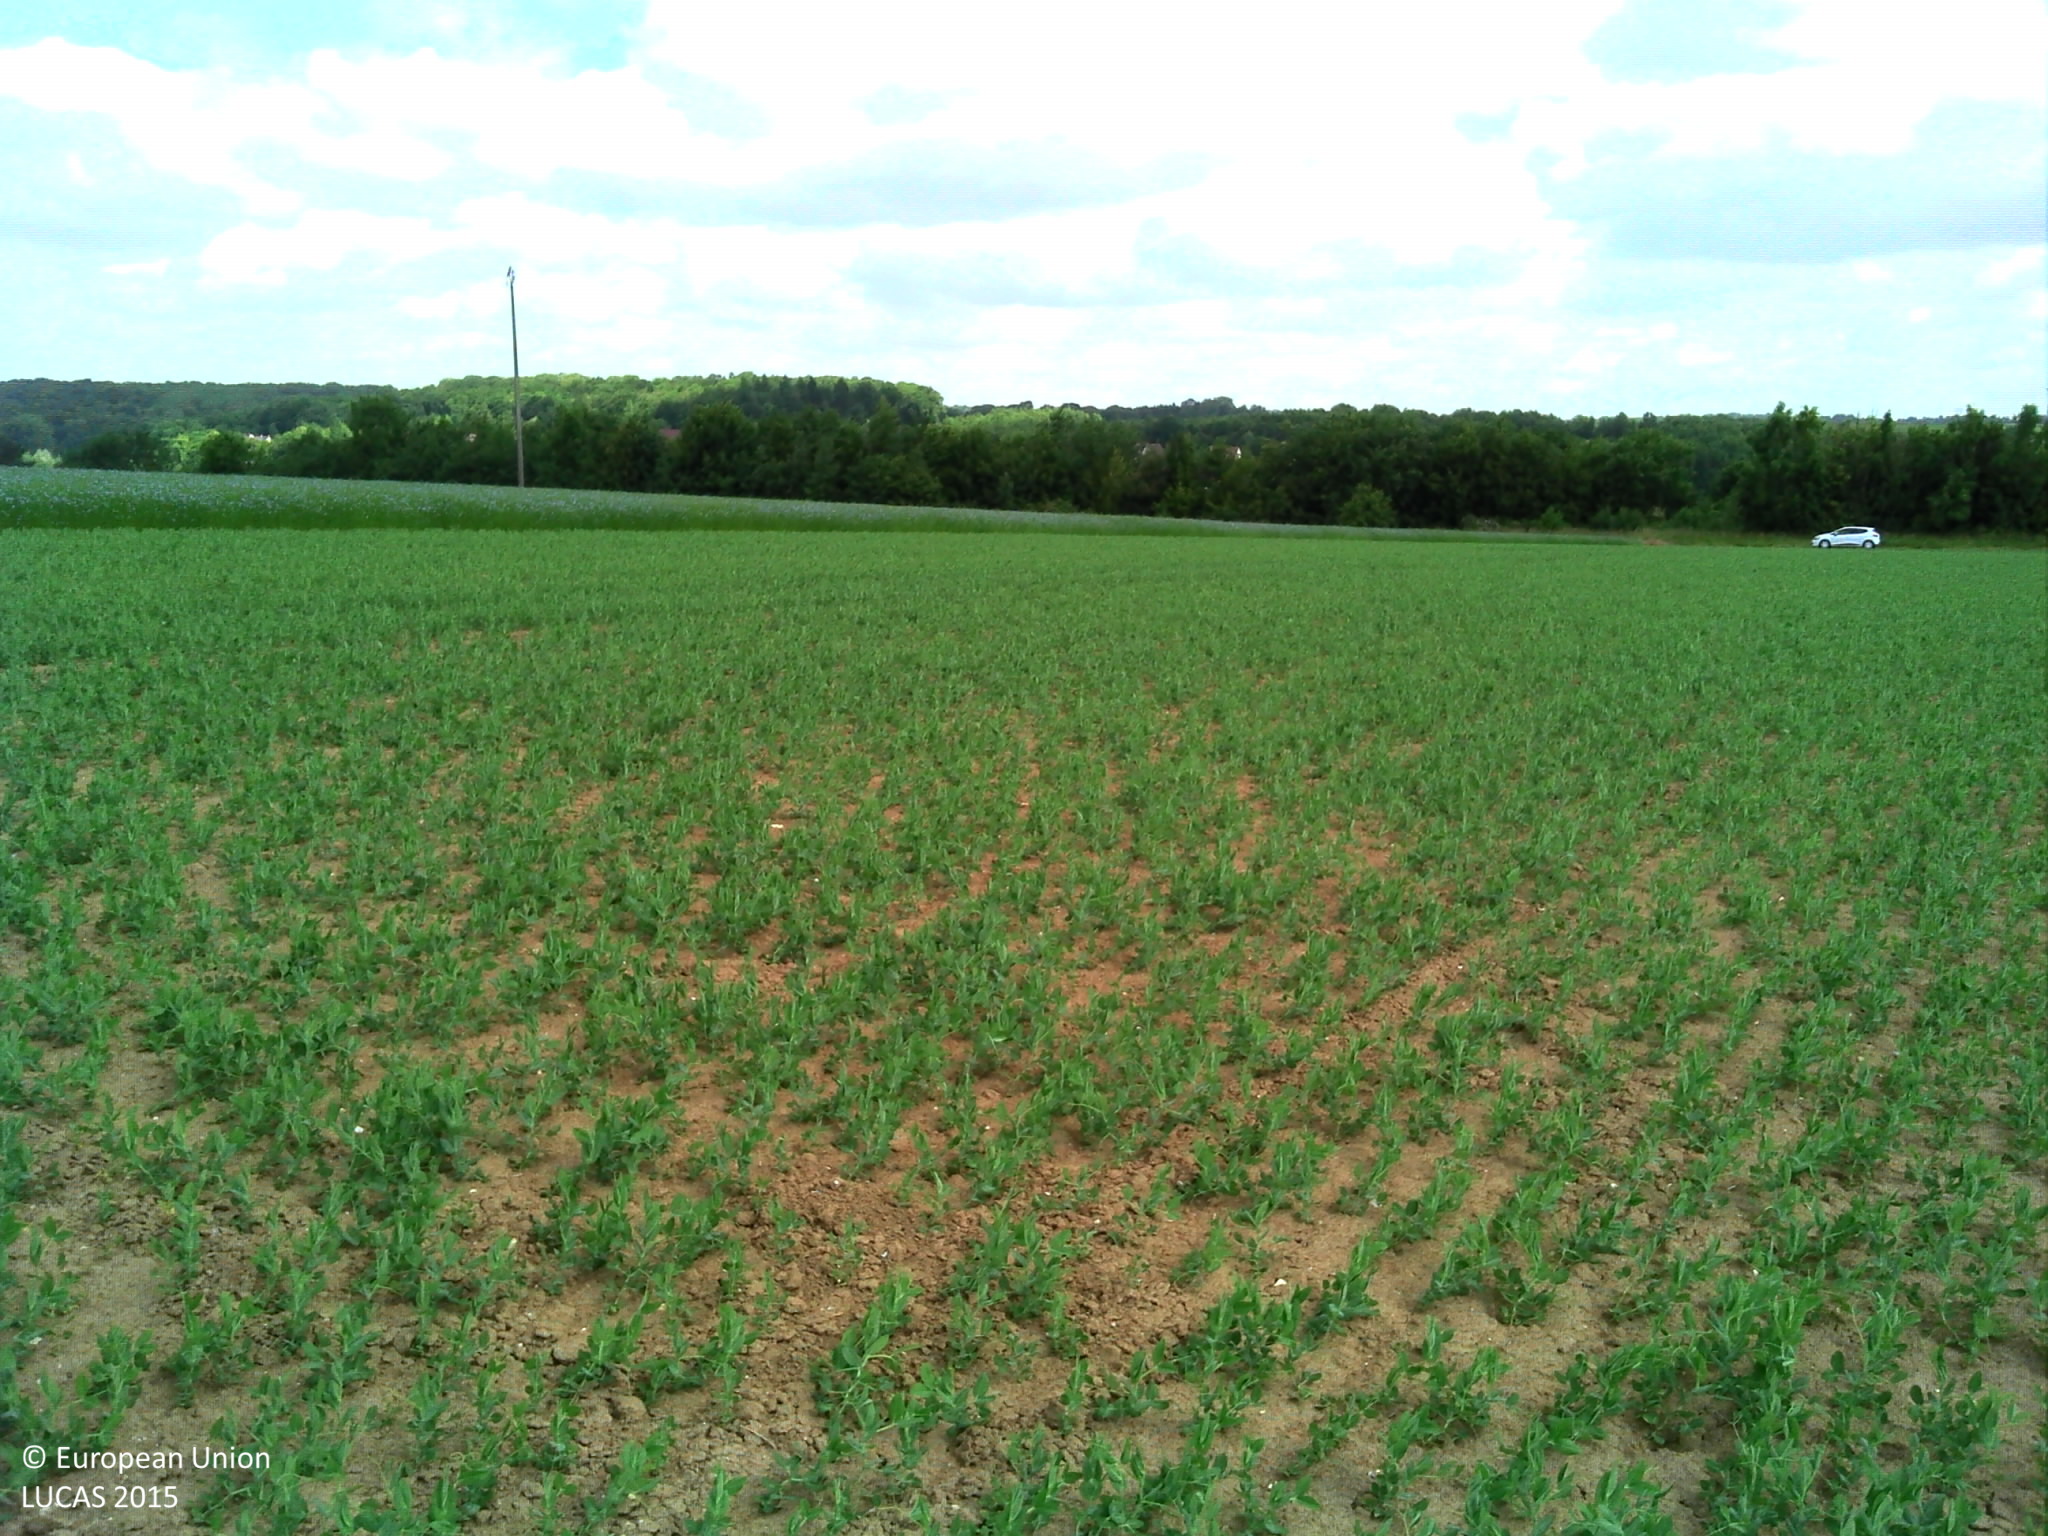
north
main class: Cropland
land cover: Other fresh vegetables
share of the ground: 50 - 75 %
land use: Agriculture (excluding fallow land and kitchen gardens)
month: June
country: FR
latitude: 50.3627
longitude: 2.3816
